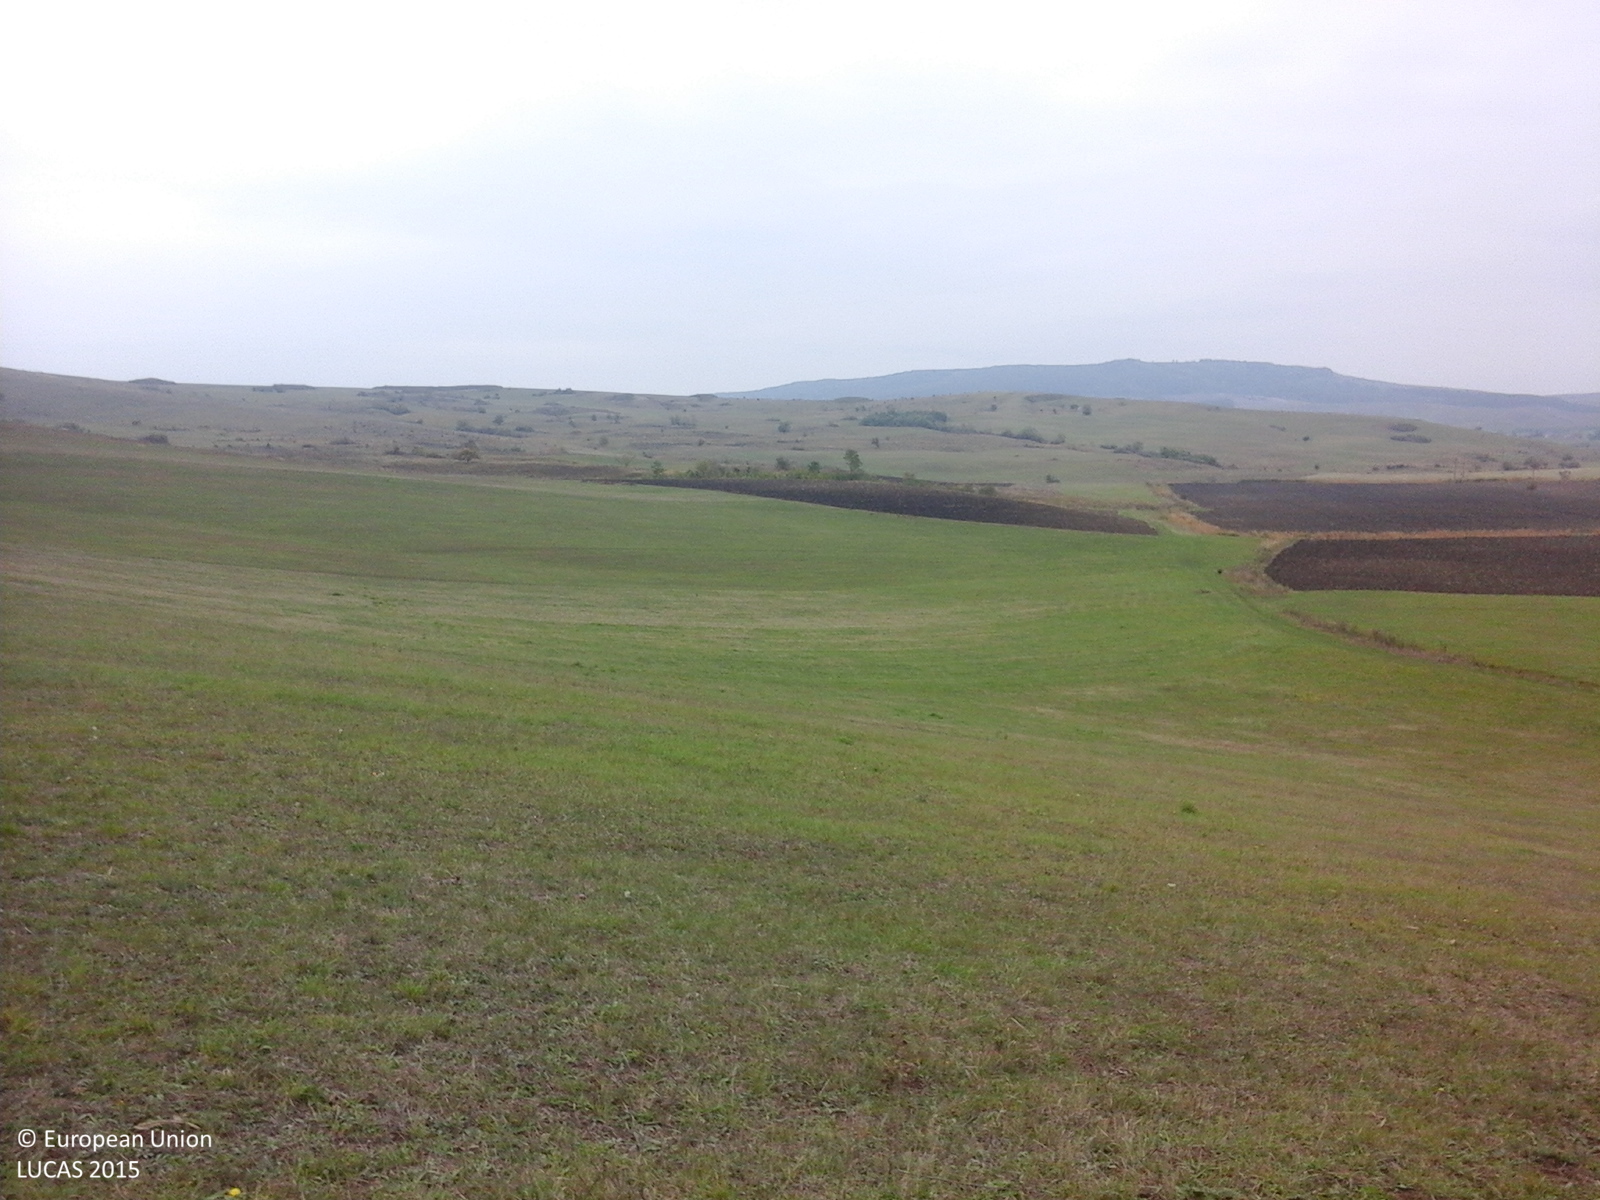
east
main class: Grassland
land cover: Grassland without tree/shrub cover
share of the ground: > 75 %
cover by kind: herbaceous plants 100 %
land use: Agriculture (excluding fallow land and kitchen gardens)
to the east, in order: Grassland without tree/shrub cover
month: October
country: RO
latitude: 46.1104
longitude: 25.2507
